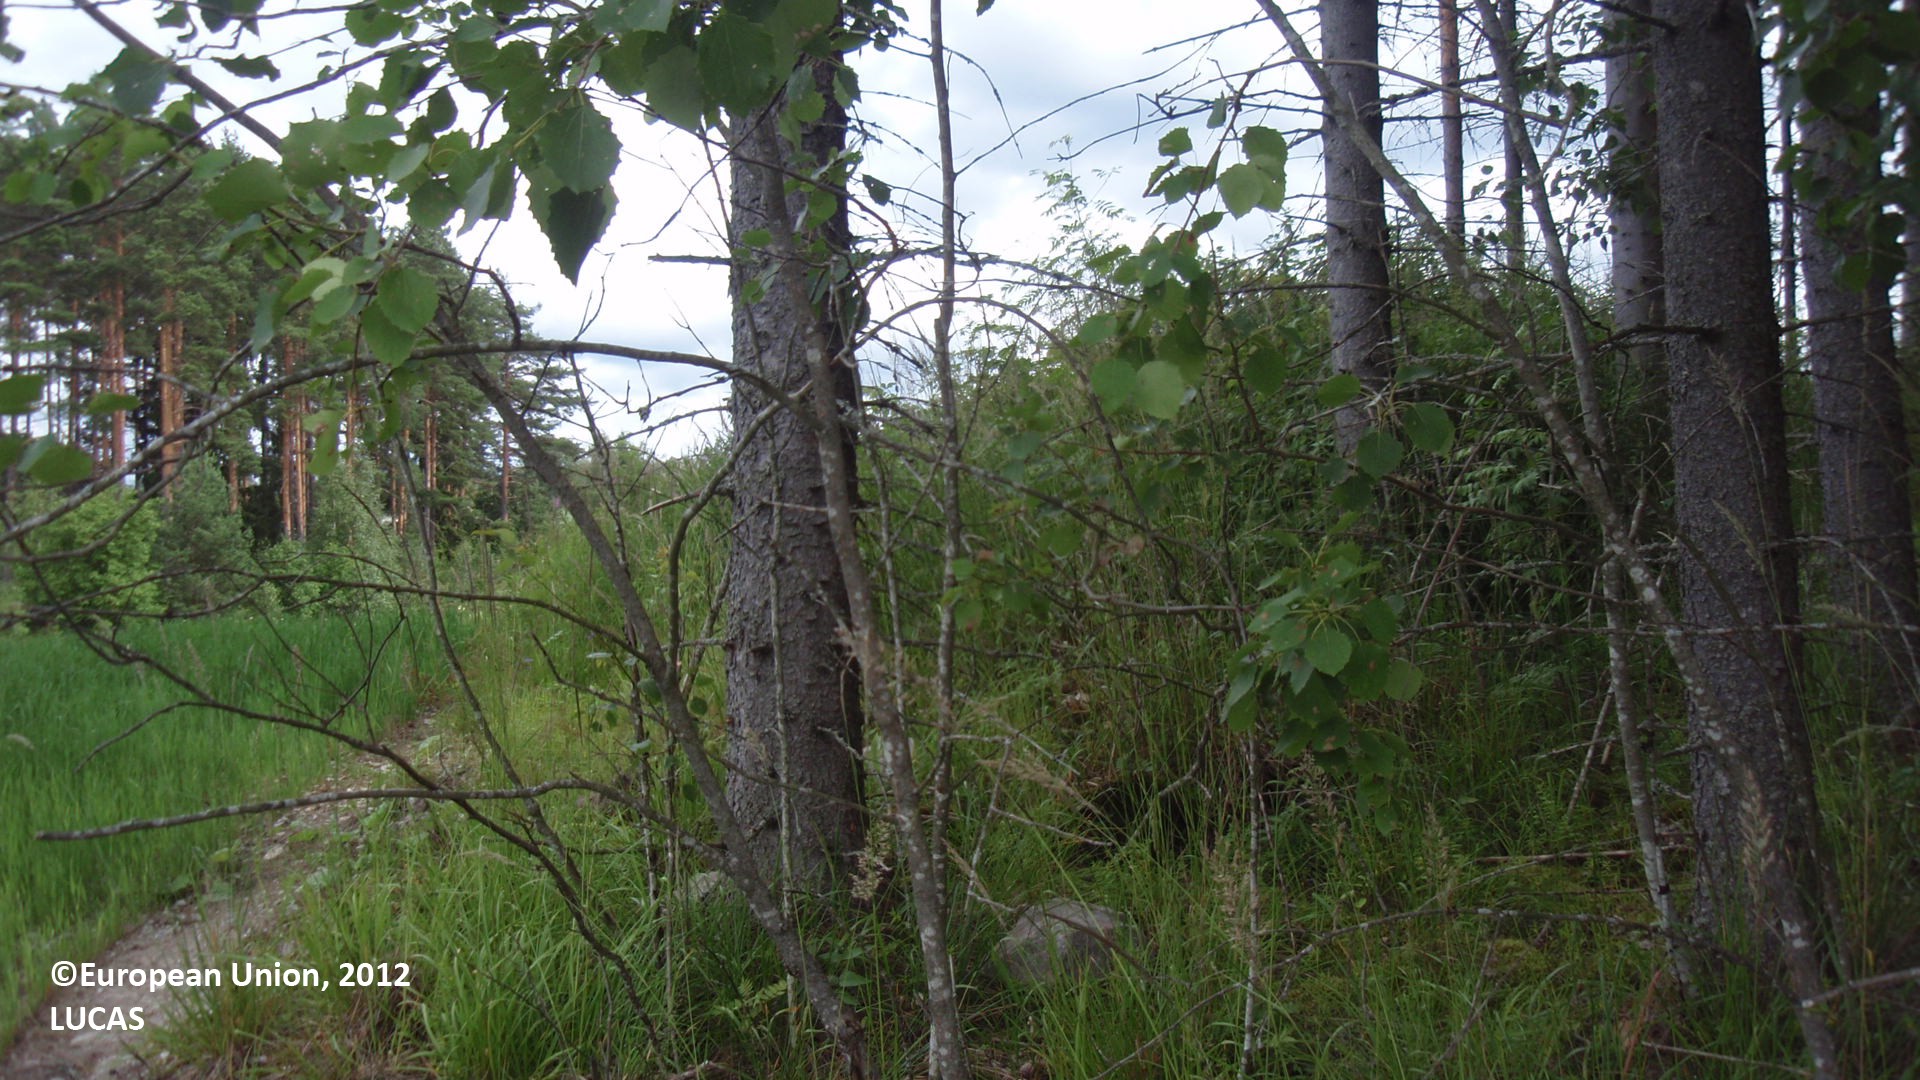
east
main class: Cropland
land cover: Oats
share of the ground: > 75 %
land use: Agriculture (excluding fallow land and kitchen gardens)
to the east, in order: Oats; Ditches and canals; Oats; Ditches and canals; Oats; Ditches and canals; Oats; Ditches and canals; Potatoes; Grass margins; Broadleaved woodland; Spruce dominated coniferous woodland; Grass margins; Oats; Paved roads, cycling and walking lanes
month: July
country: FI
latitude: 61.3169
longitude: 28.6537
